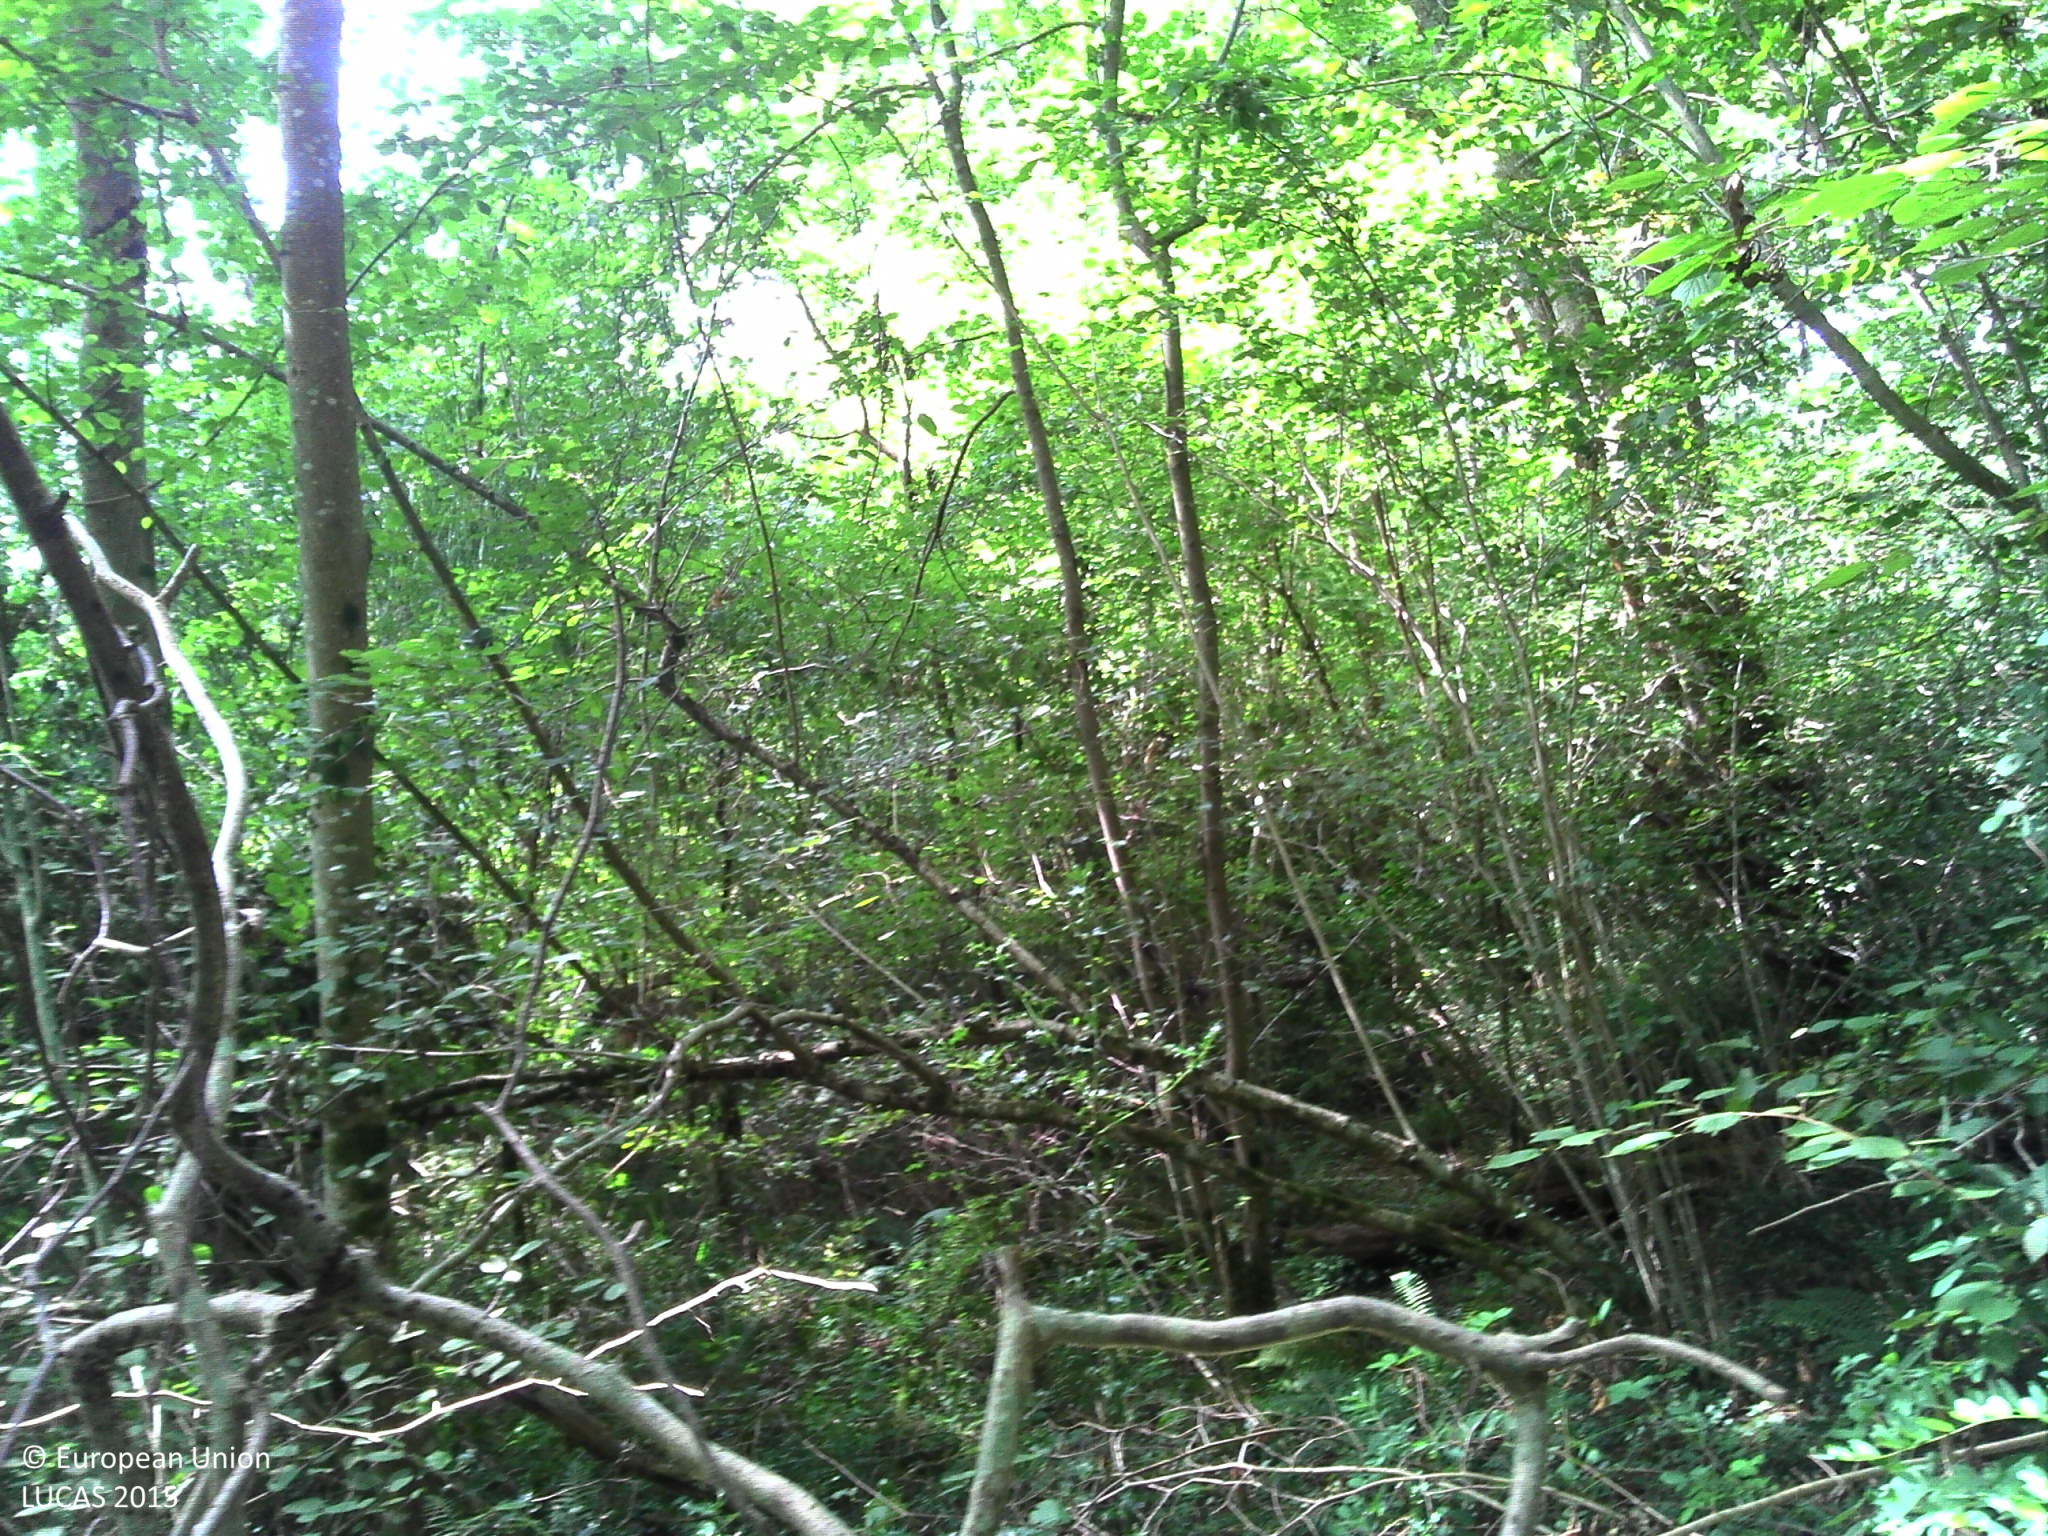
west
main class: Woodland
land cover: Broadleaved woodland
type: beech forest
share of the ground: > 75 %
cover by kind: broadleaved forest trees 75 %, shrubs 10 %, herbaceous plants 10 %, lichens and mosses 5 %
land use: Forestry
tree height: > 5 m
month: September
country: FR
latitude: 43.2564
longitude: -0.4653
